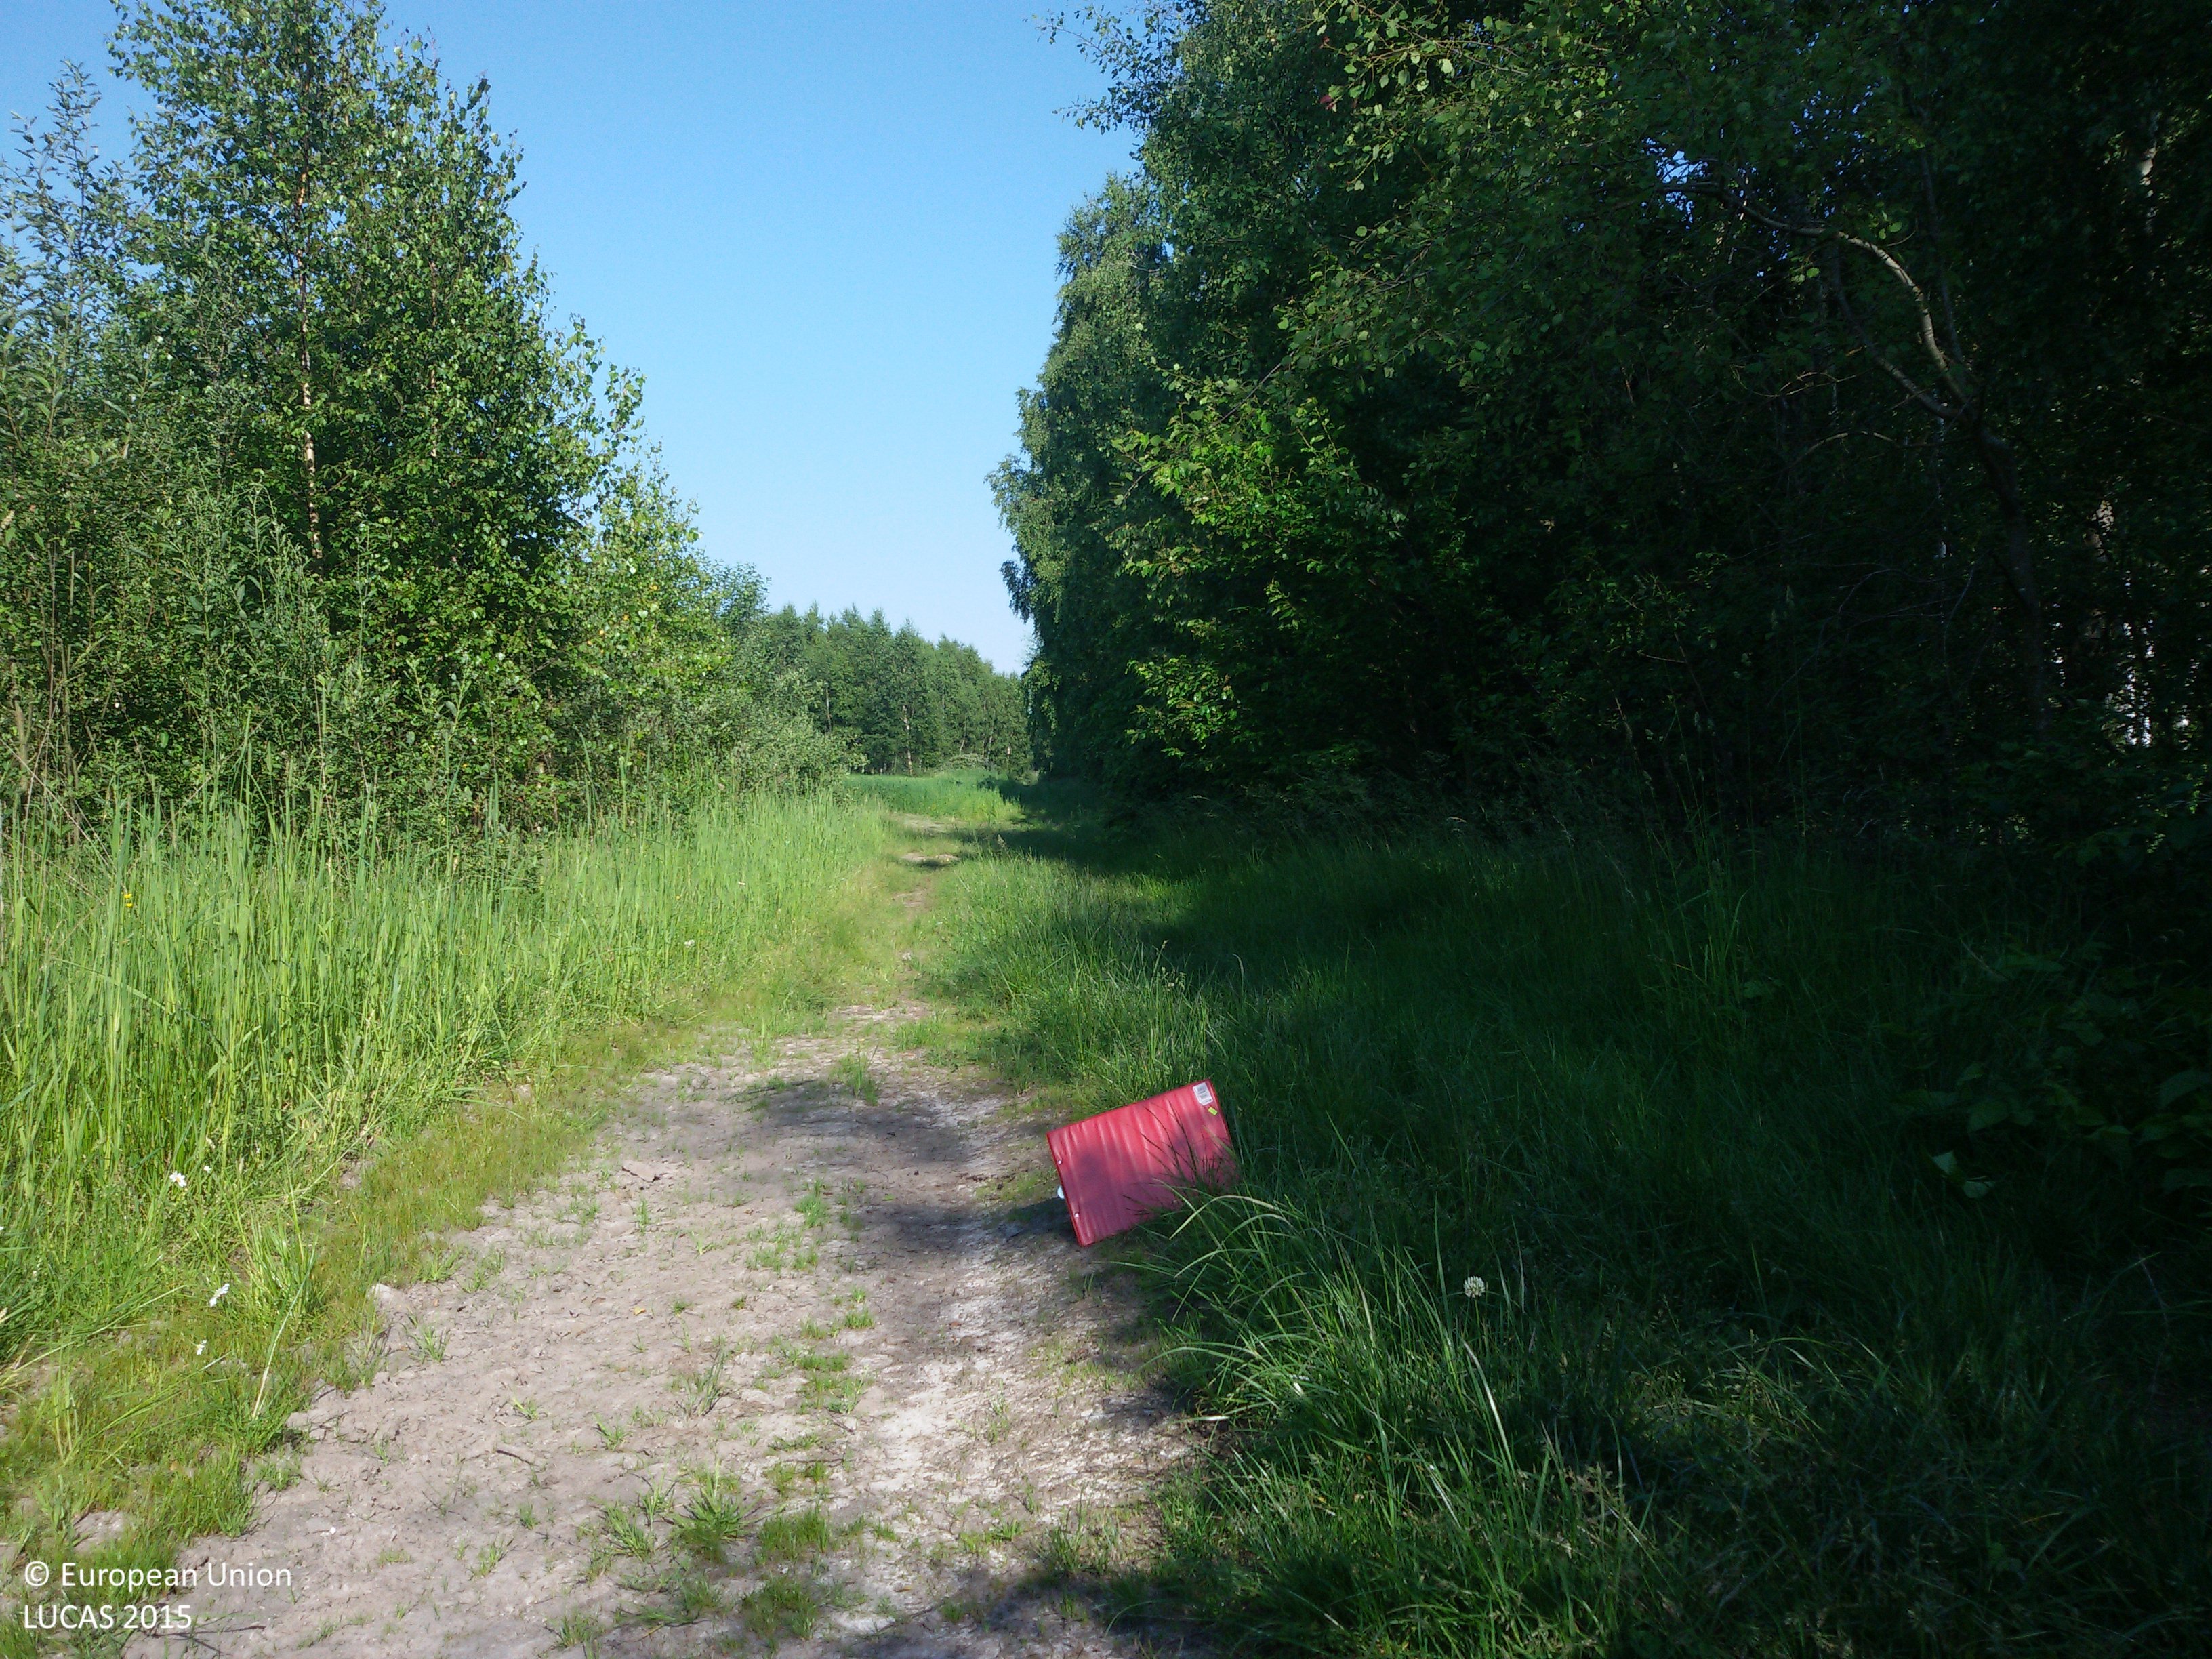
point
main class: Woodland
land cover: Broadleaved woodland
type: non-riverine alder, birch or aspen forest
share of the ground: 50 - 75 %
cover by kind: broadleaved forest trees 60 %, herbaceous plants 30 %, shrubs 10 %
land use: Forestry
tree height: < 5 m
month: June
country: PL
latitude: 51.6043
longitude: 22.9976
